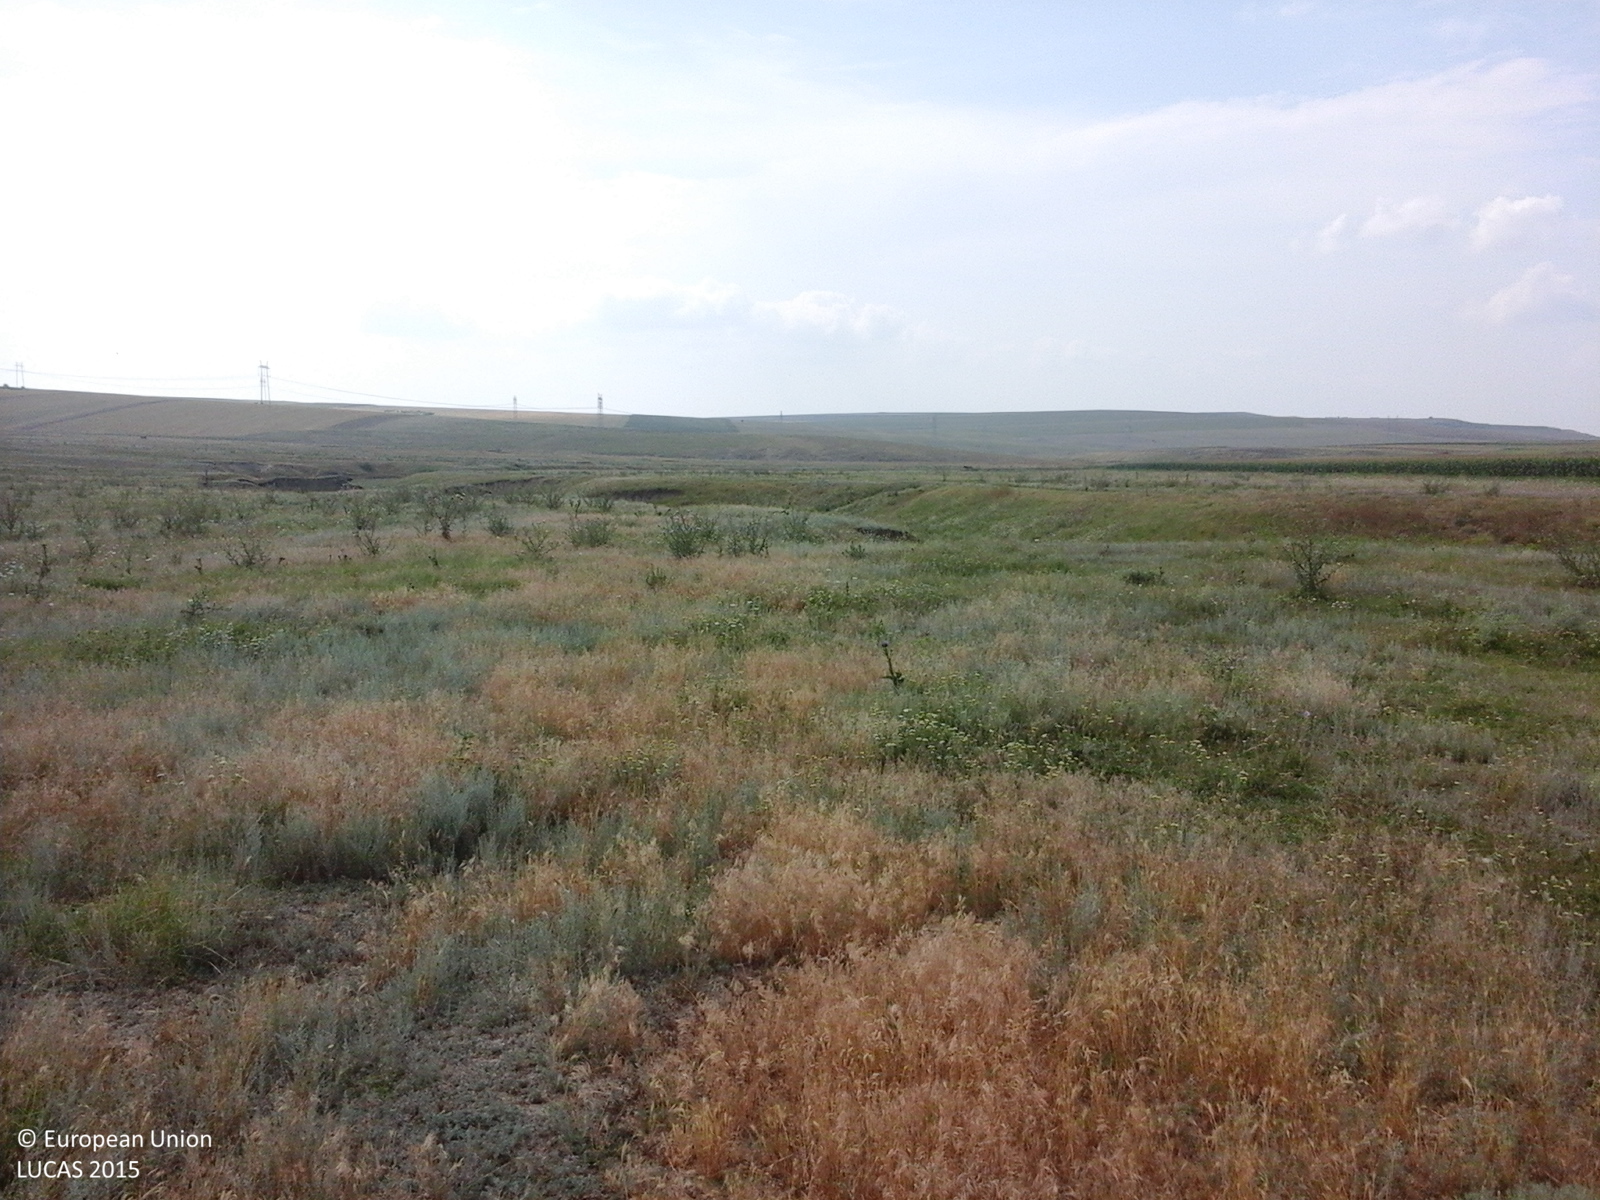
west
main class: Grassland
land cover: Spontaneously vegetated surfaces
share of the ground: > 75 %
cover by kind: herbaceous plants 100 %
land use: Agriculture (excluding fallow land and kitchen gardens)
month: July
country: RO
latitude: 44.8685
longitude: 28.2831
